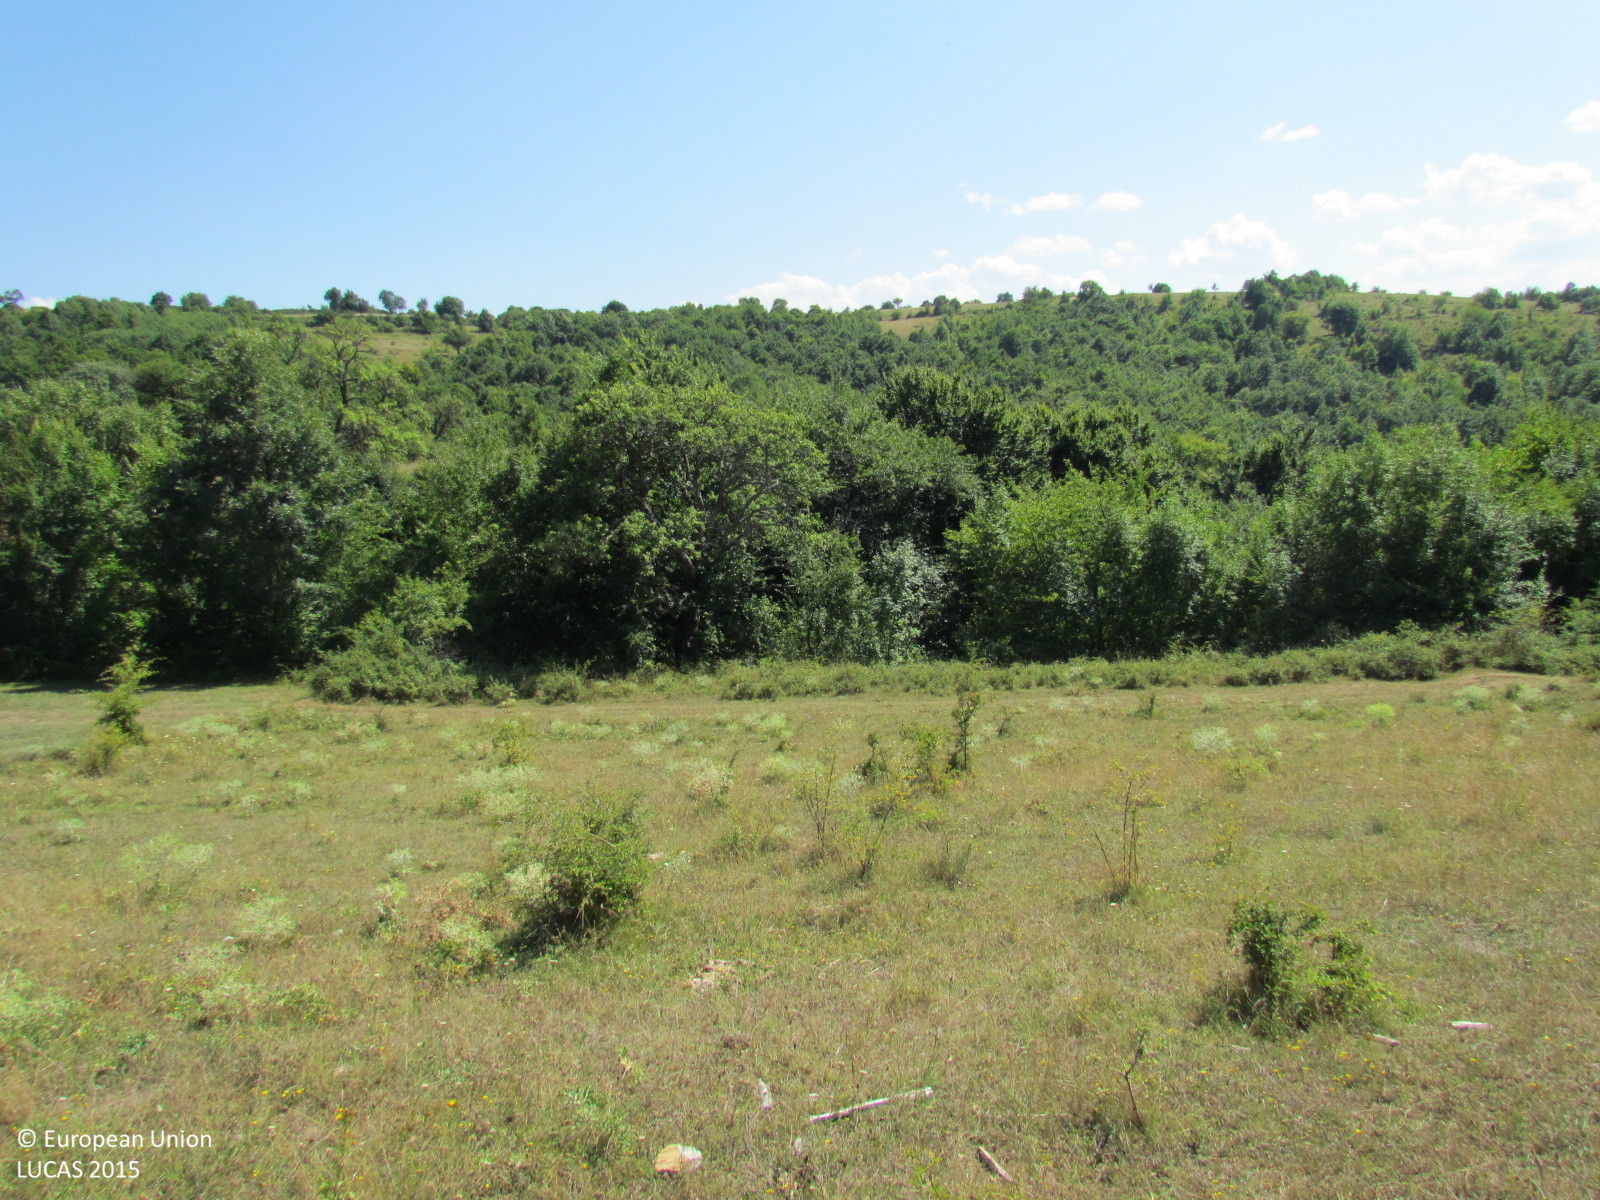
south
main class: Grassland
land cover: Grassland with sparse tree/shrub cover
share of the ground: > 75 %
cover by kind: herbaceous plants 85 %, shrubs 10 %, broadleaved forest trees 5 %
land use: Agriculture (excluding fallow land and kitchen gardens)
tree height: > 5 m
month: July
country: BG
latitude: 42.8773
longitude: 27.4444
